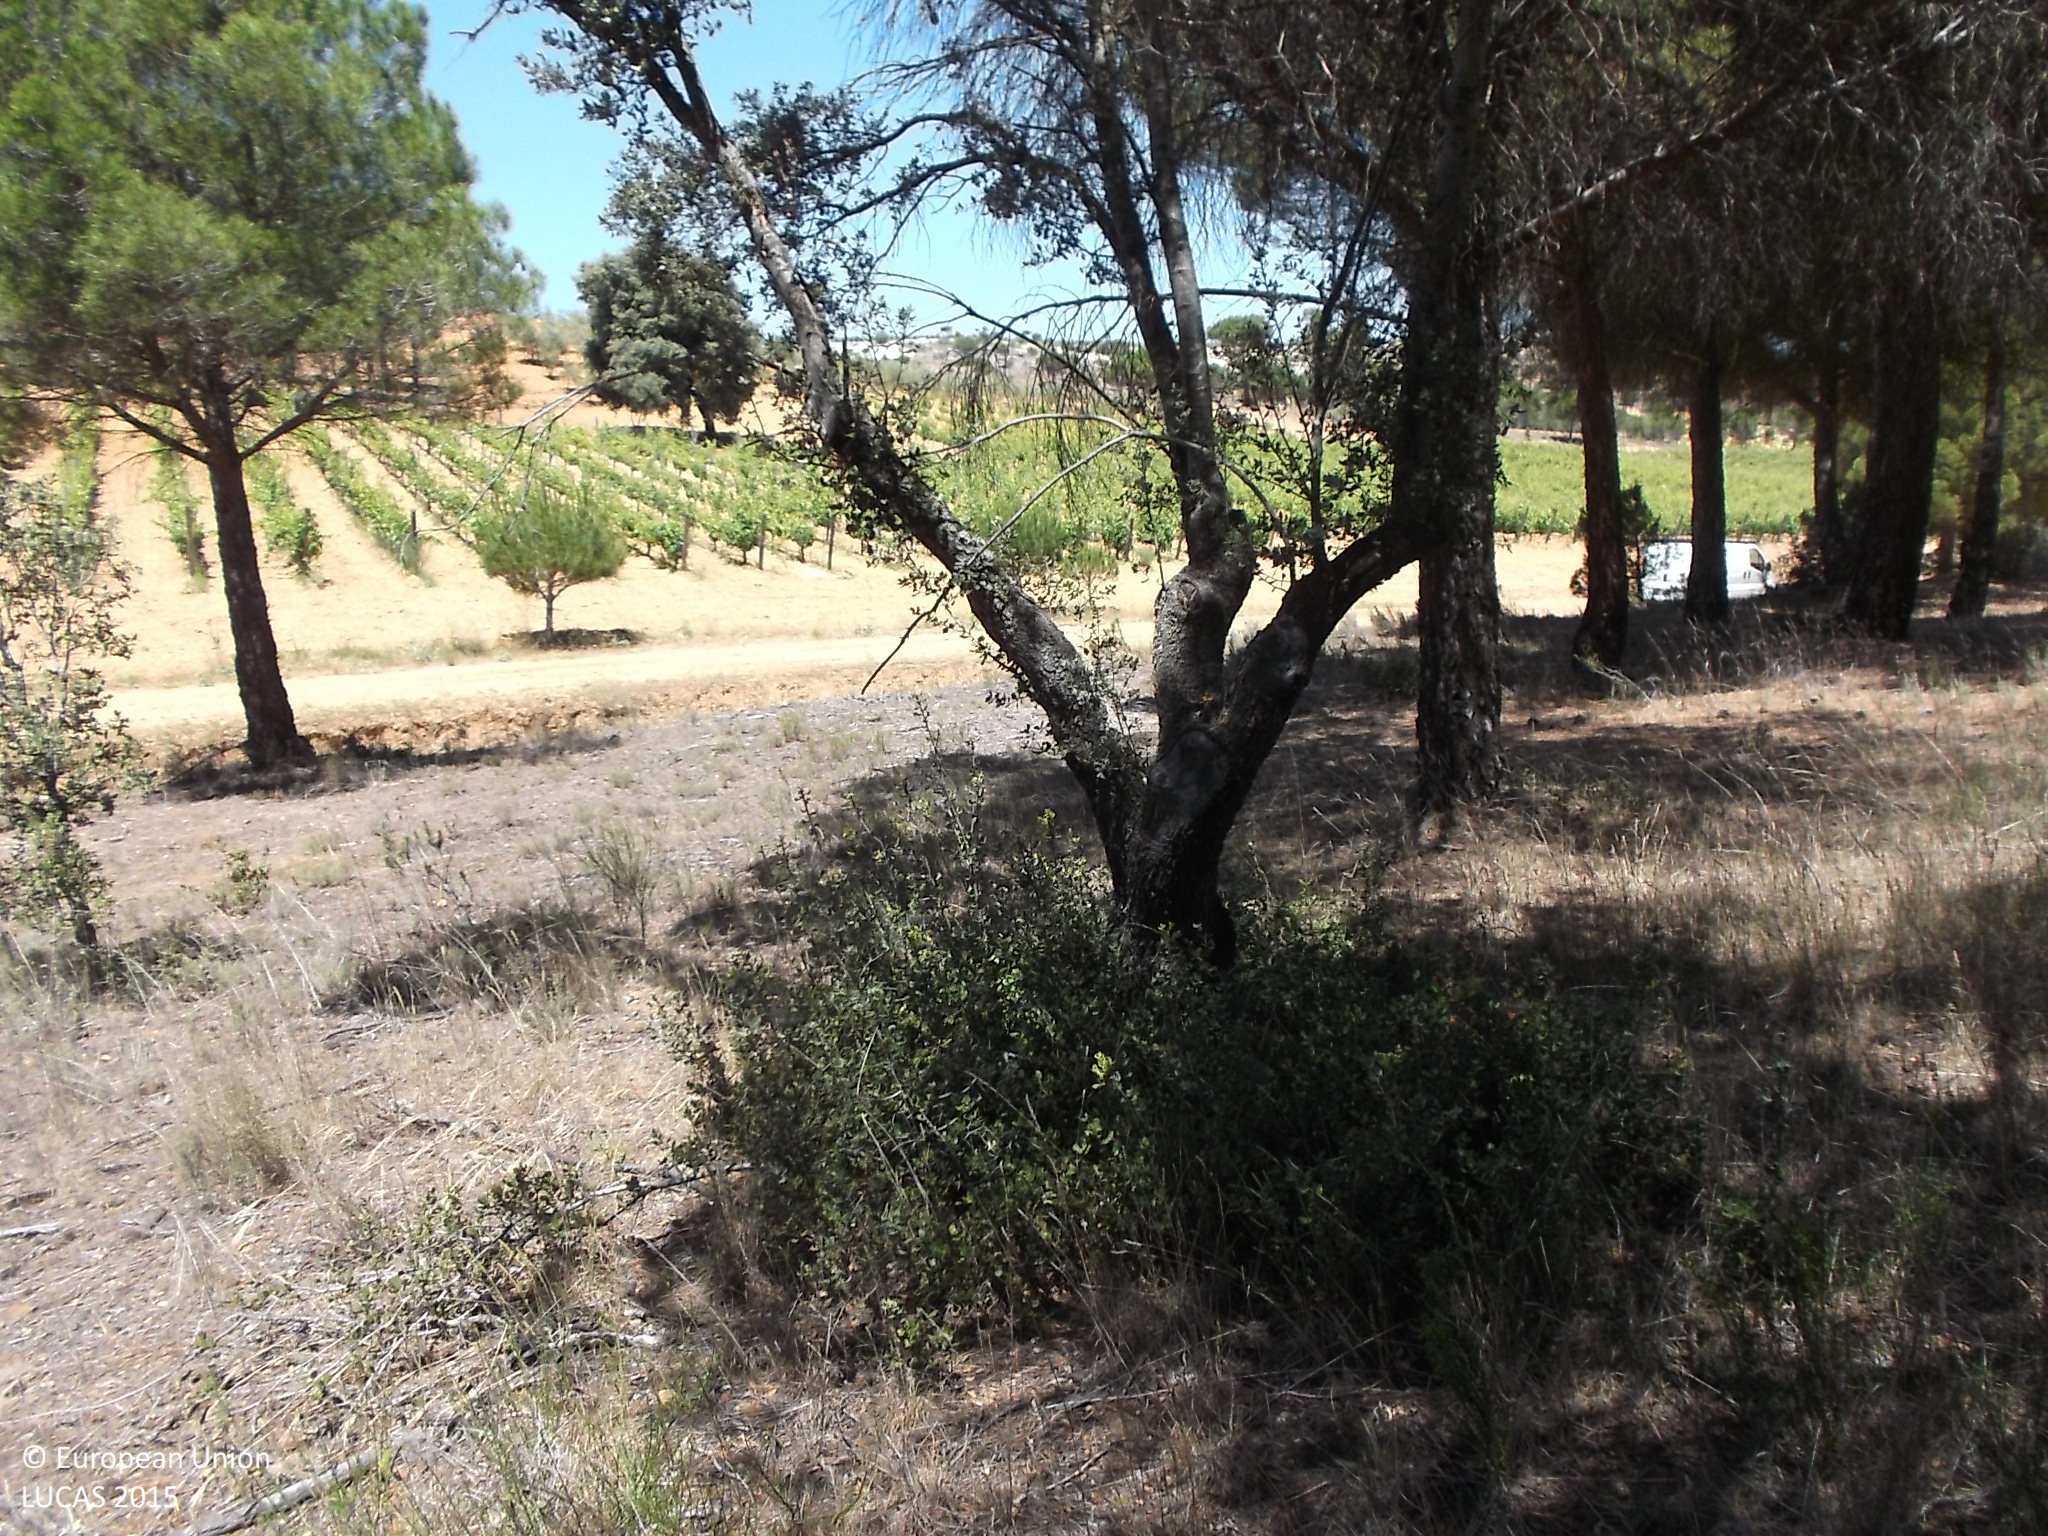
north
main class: Woodland
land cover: Pine dominated mixed woodland
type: coniferous forest of the mediterranean region
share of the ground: > 75 %
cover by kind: coniferous forest trees 50 %, broadleaved forest trees 25 %, herbaceous plants 25 %
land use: Forestry
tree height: > 5 m
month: June
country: ES
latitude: 41.4368
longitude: -5.4829
